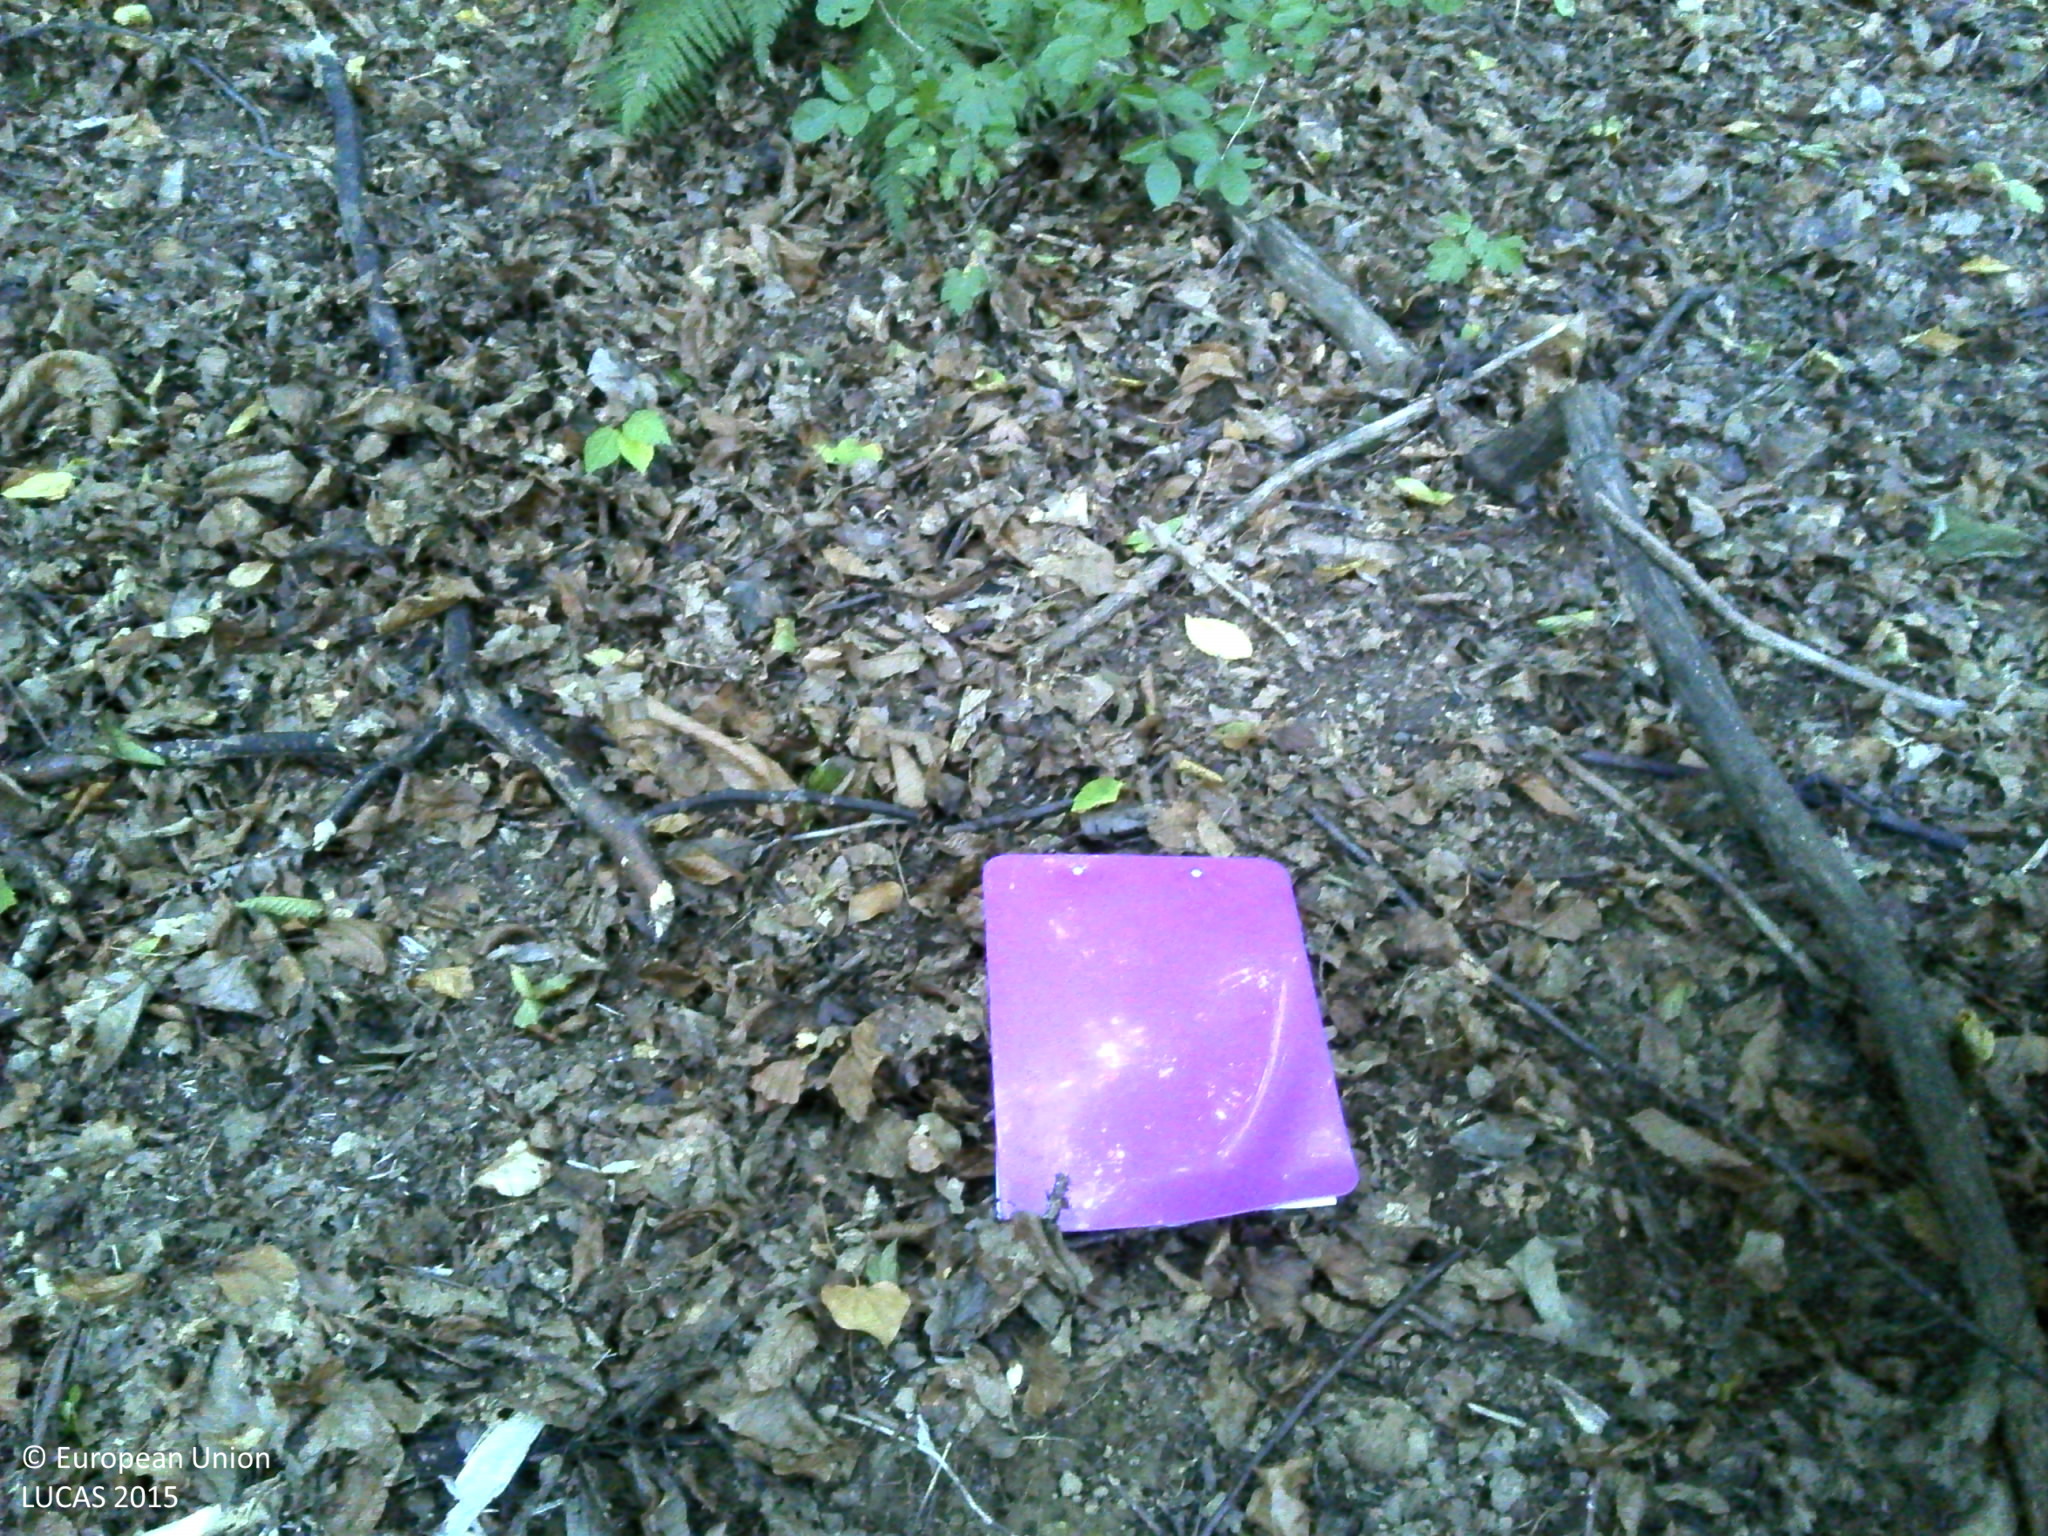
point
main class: Woodland
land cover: Broadleaved woodland
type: acidophilous oak and oak-birch forest
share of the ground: > 75 %
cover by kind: broadleaved forest trees 100 %
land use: Forestry
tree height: > 5 m
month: August
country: HR
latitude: 45.2586
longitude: 16.3560
